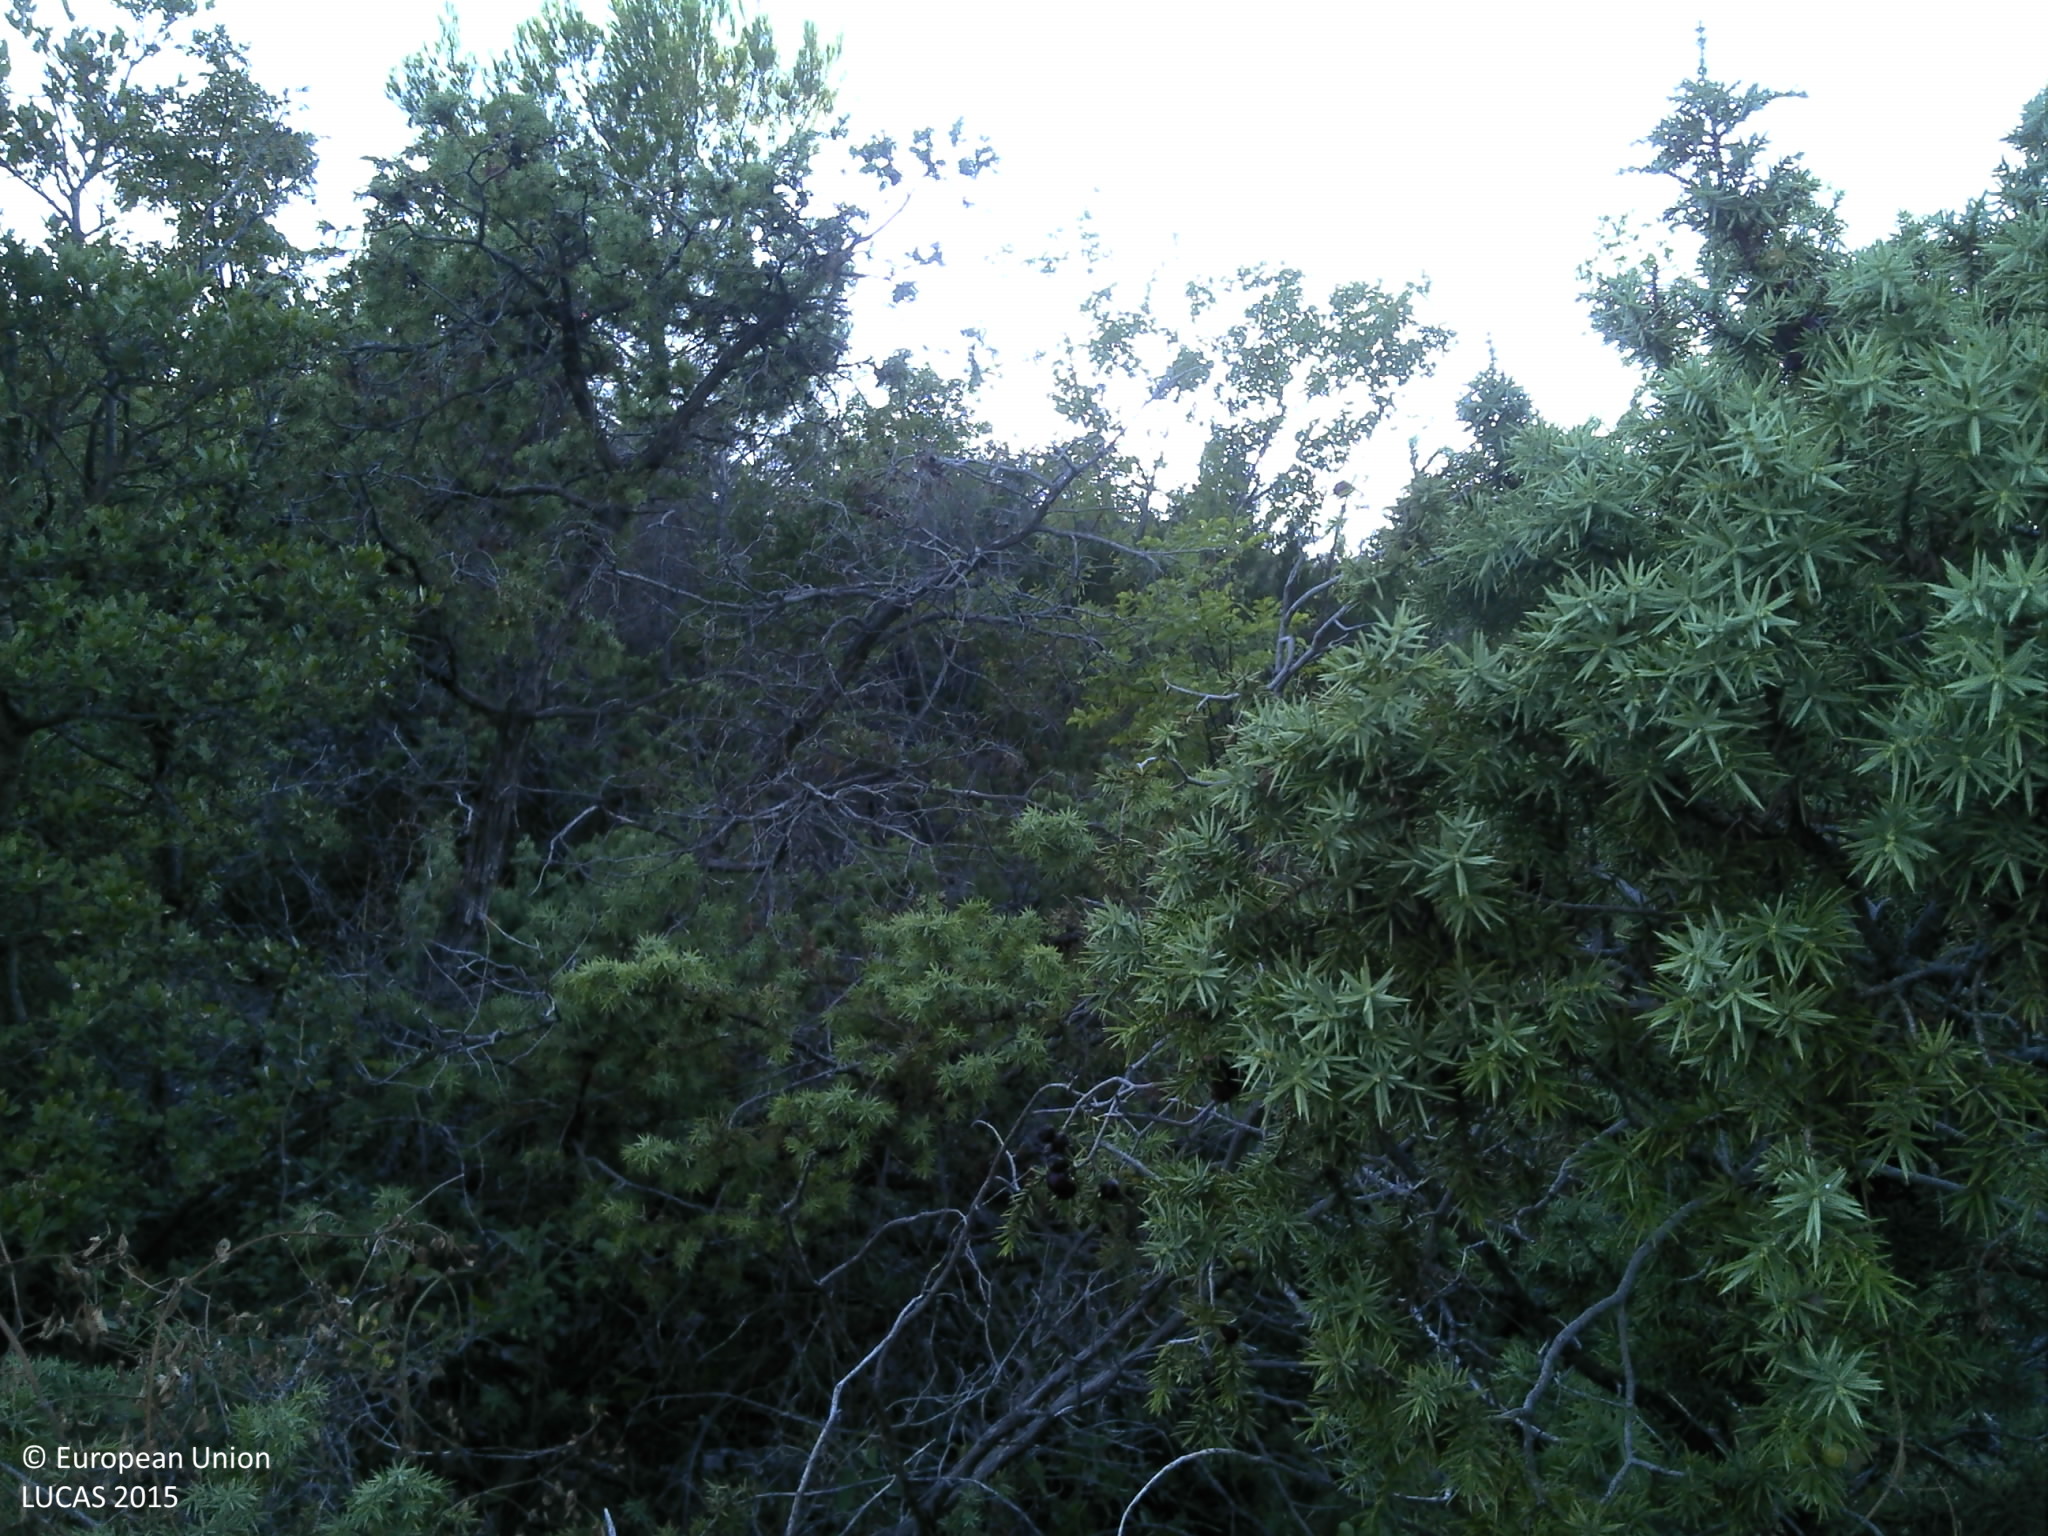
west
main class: Woodland
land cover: Broadleaved woodland
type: thermophilous deciduous forest
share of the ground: 25 - 50 %
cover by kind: broadleaved forest trees 40 %, shrubs 25 %, consolidated bare surface 25 %, coniferous forest trees 5 %, unconsolidated bare surface 5 %
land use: Semi-natural and natural areas not in use
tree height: > 5 m
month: September
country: HR
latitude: 43.8528
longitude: 15.9753
